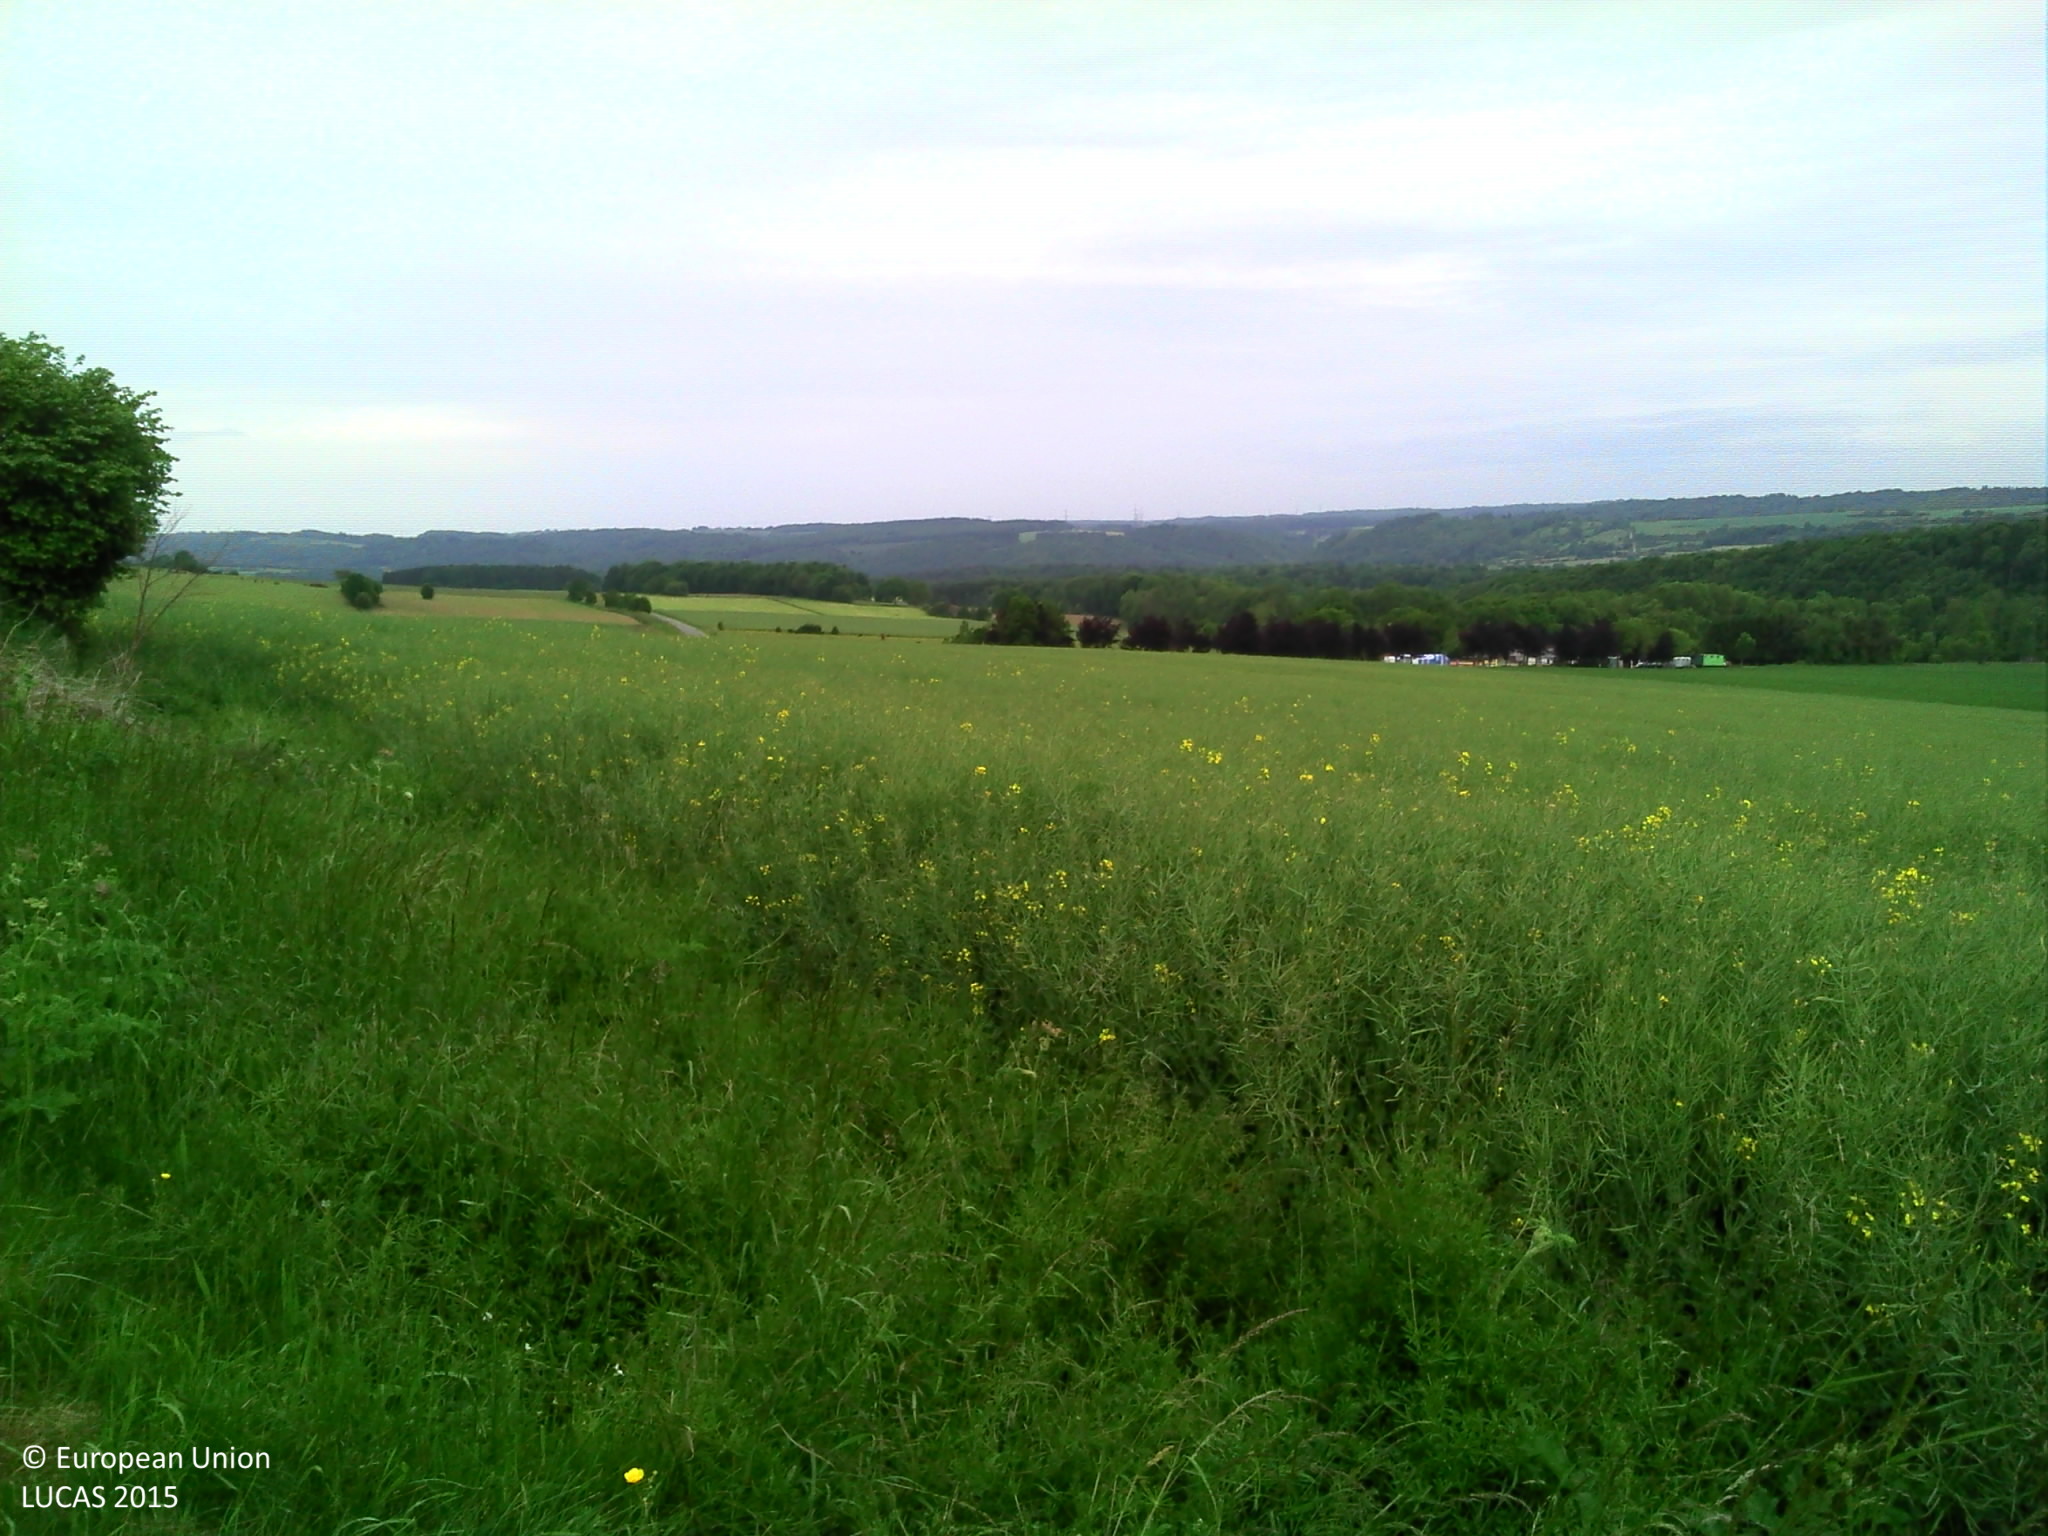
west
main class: Cropland
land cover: Rape and turnip rape
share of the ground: > 75 %
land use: Agriculture (excluding fallow land and kitchen gardens)
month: June
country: BE
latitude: 50.4412
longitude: 5.5911
